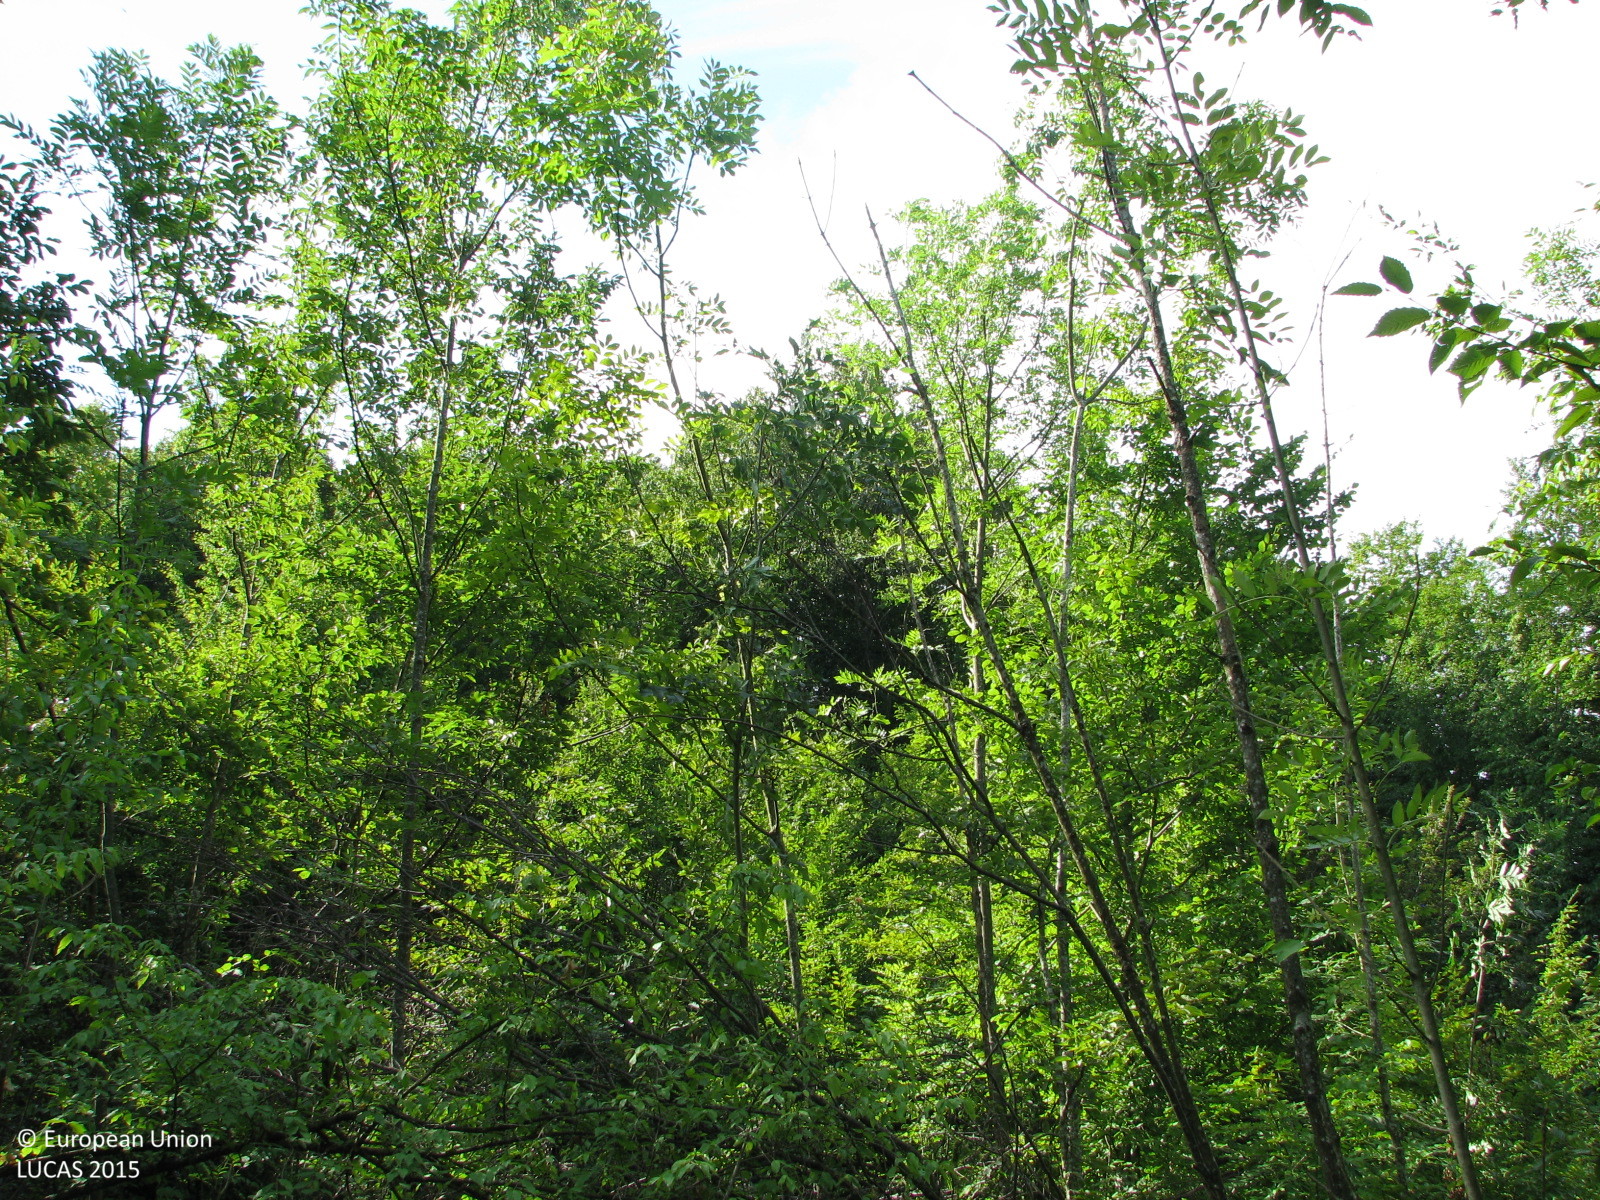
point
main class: Woodland
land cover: Broadleaved woodland
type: beech forest
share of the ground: > 75 %
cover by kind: broadleaved forest trees 80 %, shrubs 15 %, herbaceous plants 5 %
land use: Forestry
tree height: > 5 m
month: August
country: BG
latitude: 42.9241
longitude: 26.1765
